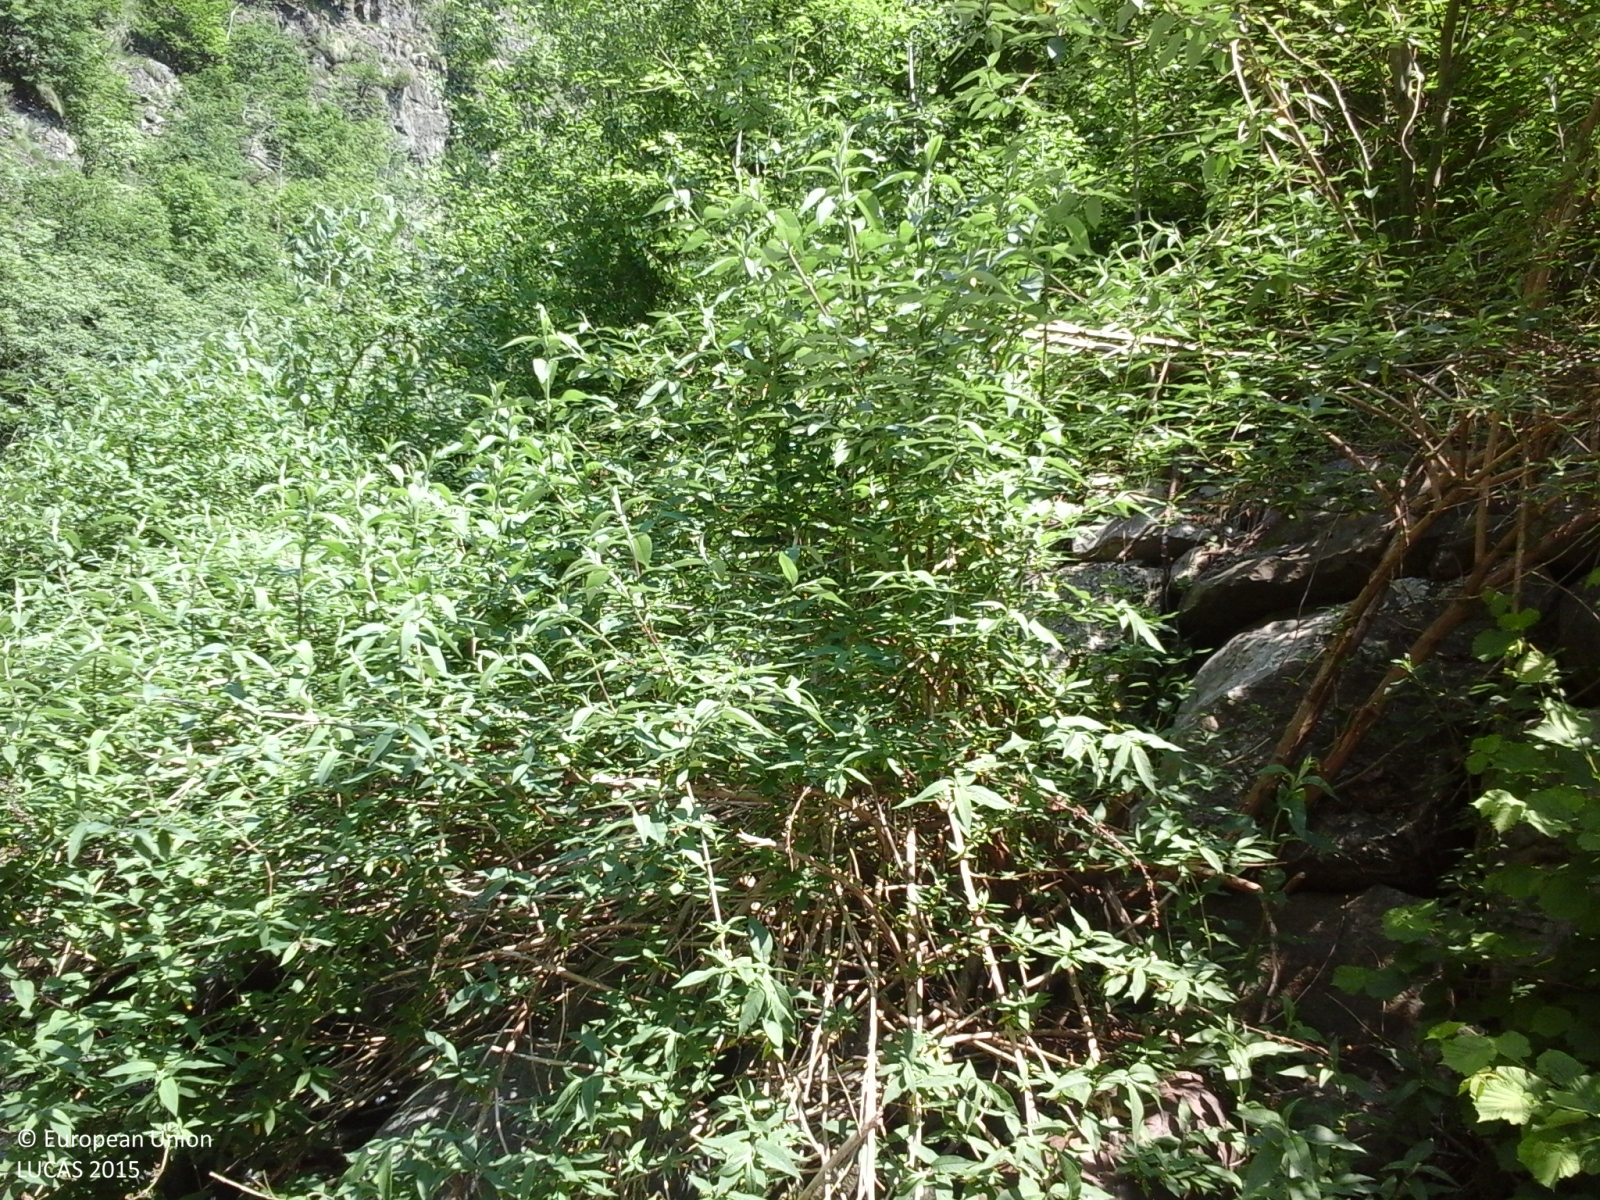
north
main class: Woodland
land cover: Broadleaved woodland
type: mesophytic deciduous forest
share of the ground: > 75 %
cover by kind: broadleaved forest trees 100 %
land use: Forestry
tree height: > 5 m
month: June
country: IT
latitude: 45.8673
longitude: 8.1863
